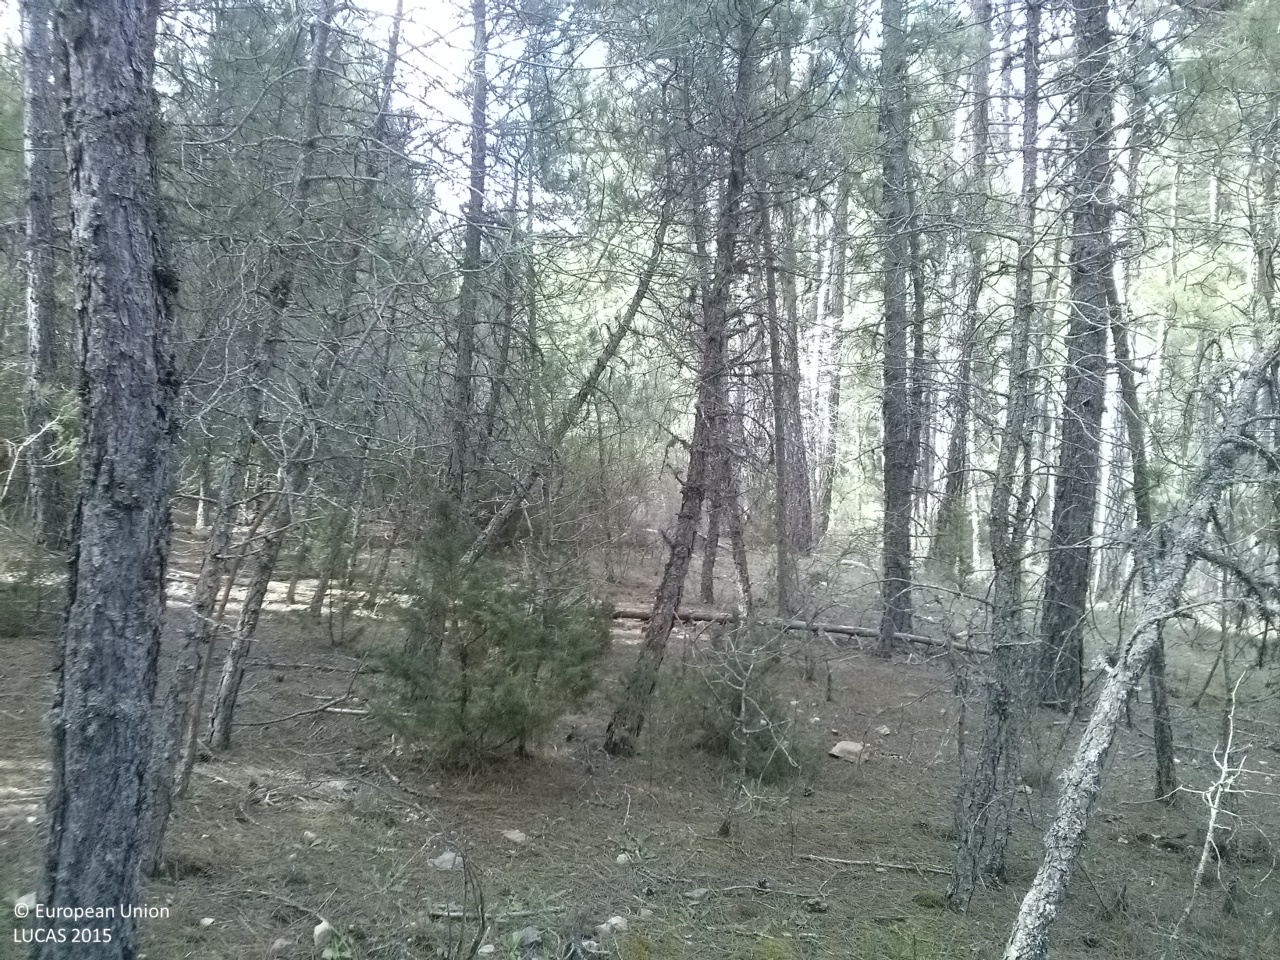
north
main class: Woodland
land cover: Pine dominated coniferous woodland
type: coniferous forest of the mediterranean region
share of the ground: > 75 %
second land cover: Grassland without tree/shrub cover
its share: 10 - 25 %
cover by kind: coniferous forest trees 85 %, herbaceous plants 10 %, shrubs 5 %
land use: Forestry
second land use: Agriculture (excluding fallow land and kitchen gardens)
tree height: > 5 m
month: April
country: ES
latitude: 40.1190
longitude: -1.9478
